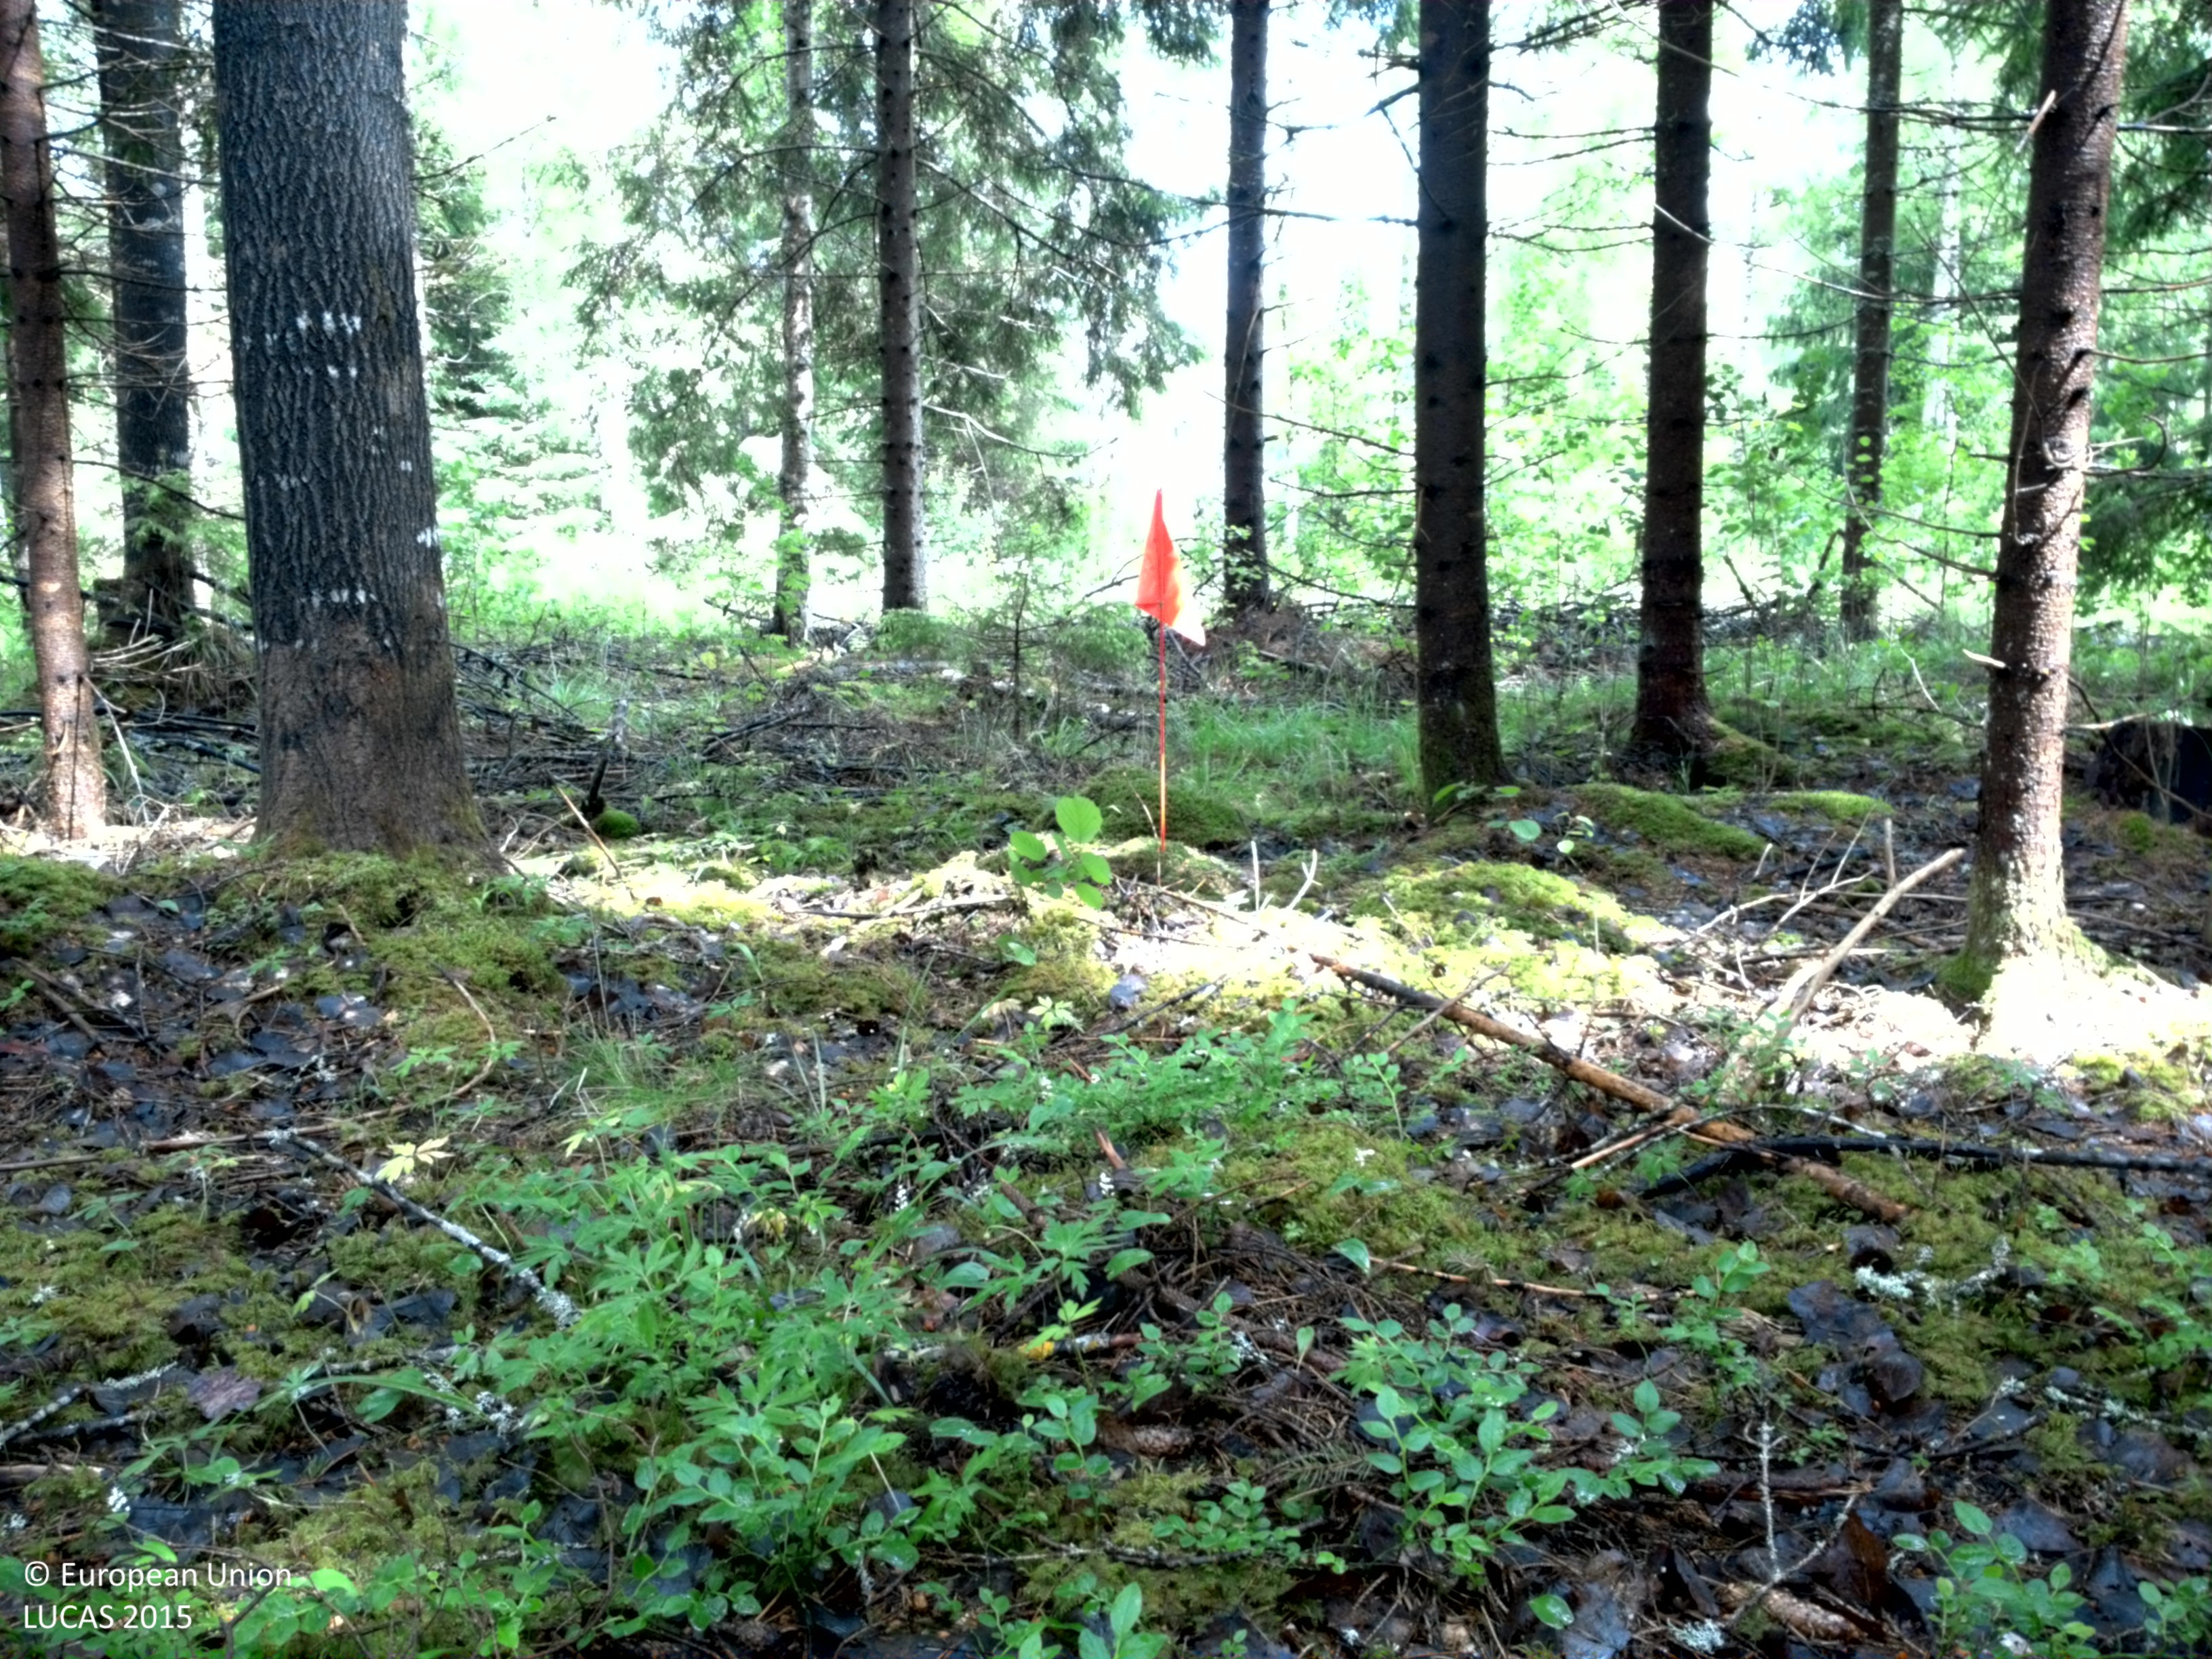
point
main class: Woodland
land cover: Spruce dominated coniferous woodland
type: boreal forest
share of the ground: > 75 %
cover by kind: coniferous forest trees 85 %, broadleaved forest trees 5 %, herbaceous plants 5 %, lichens and mosses 5 %
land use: Forestry
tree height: > 5 m
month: June
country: SE
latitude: 59.8581
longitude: 17.0805
